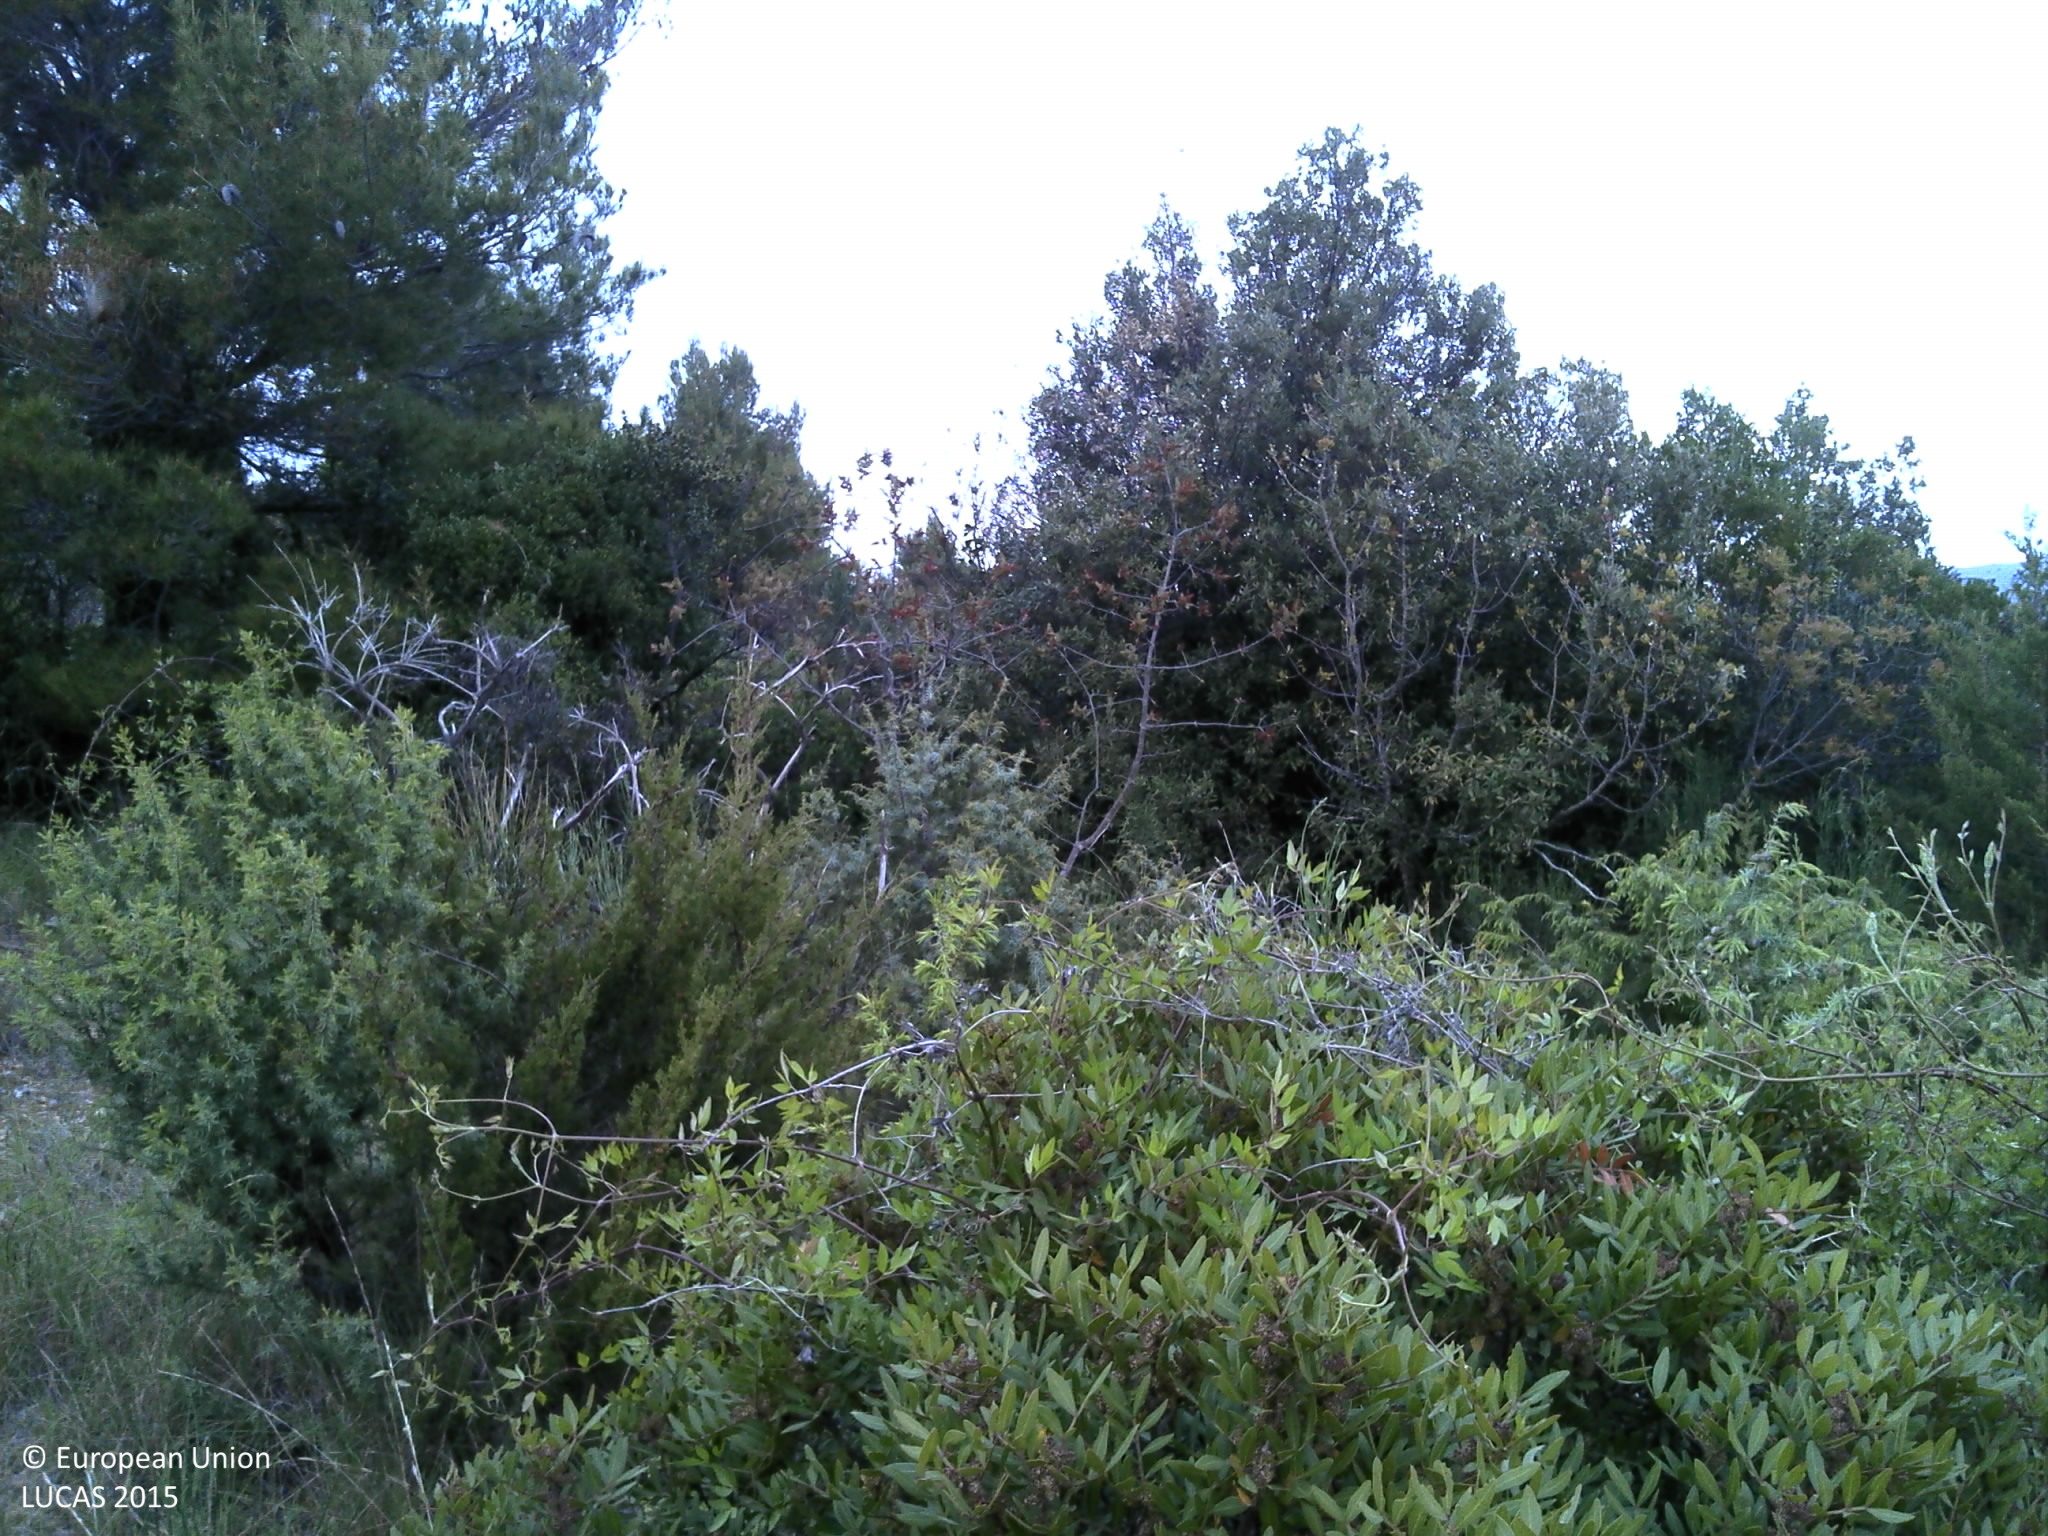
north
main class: Shrubland
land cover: Shrubland with sparse tree cover
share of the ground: 50 - 75 %
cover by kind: shrubs 45 %, herbaceous plants 30 %, unconsolidated bare surface 20 %, coniferous forest trees 5 %
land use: Semi-natural and natural areas not in use
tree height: < 5 m
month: April
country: HR
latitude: 43.7672
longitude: 15.8918
